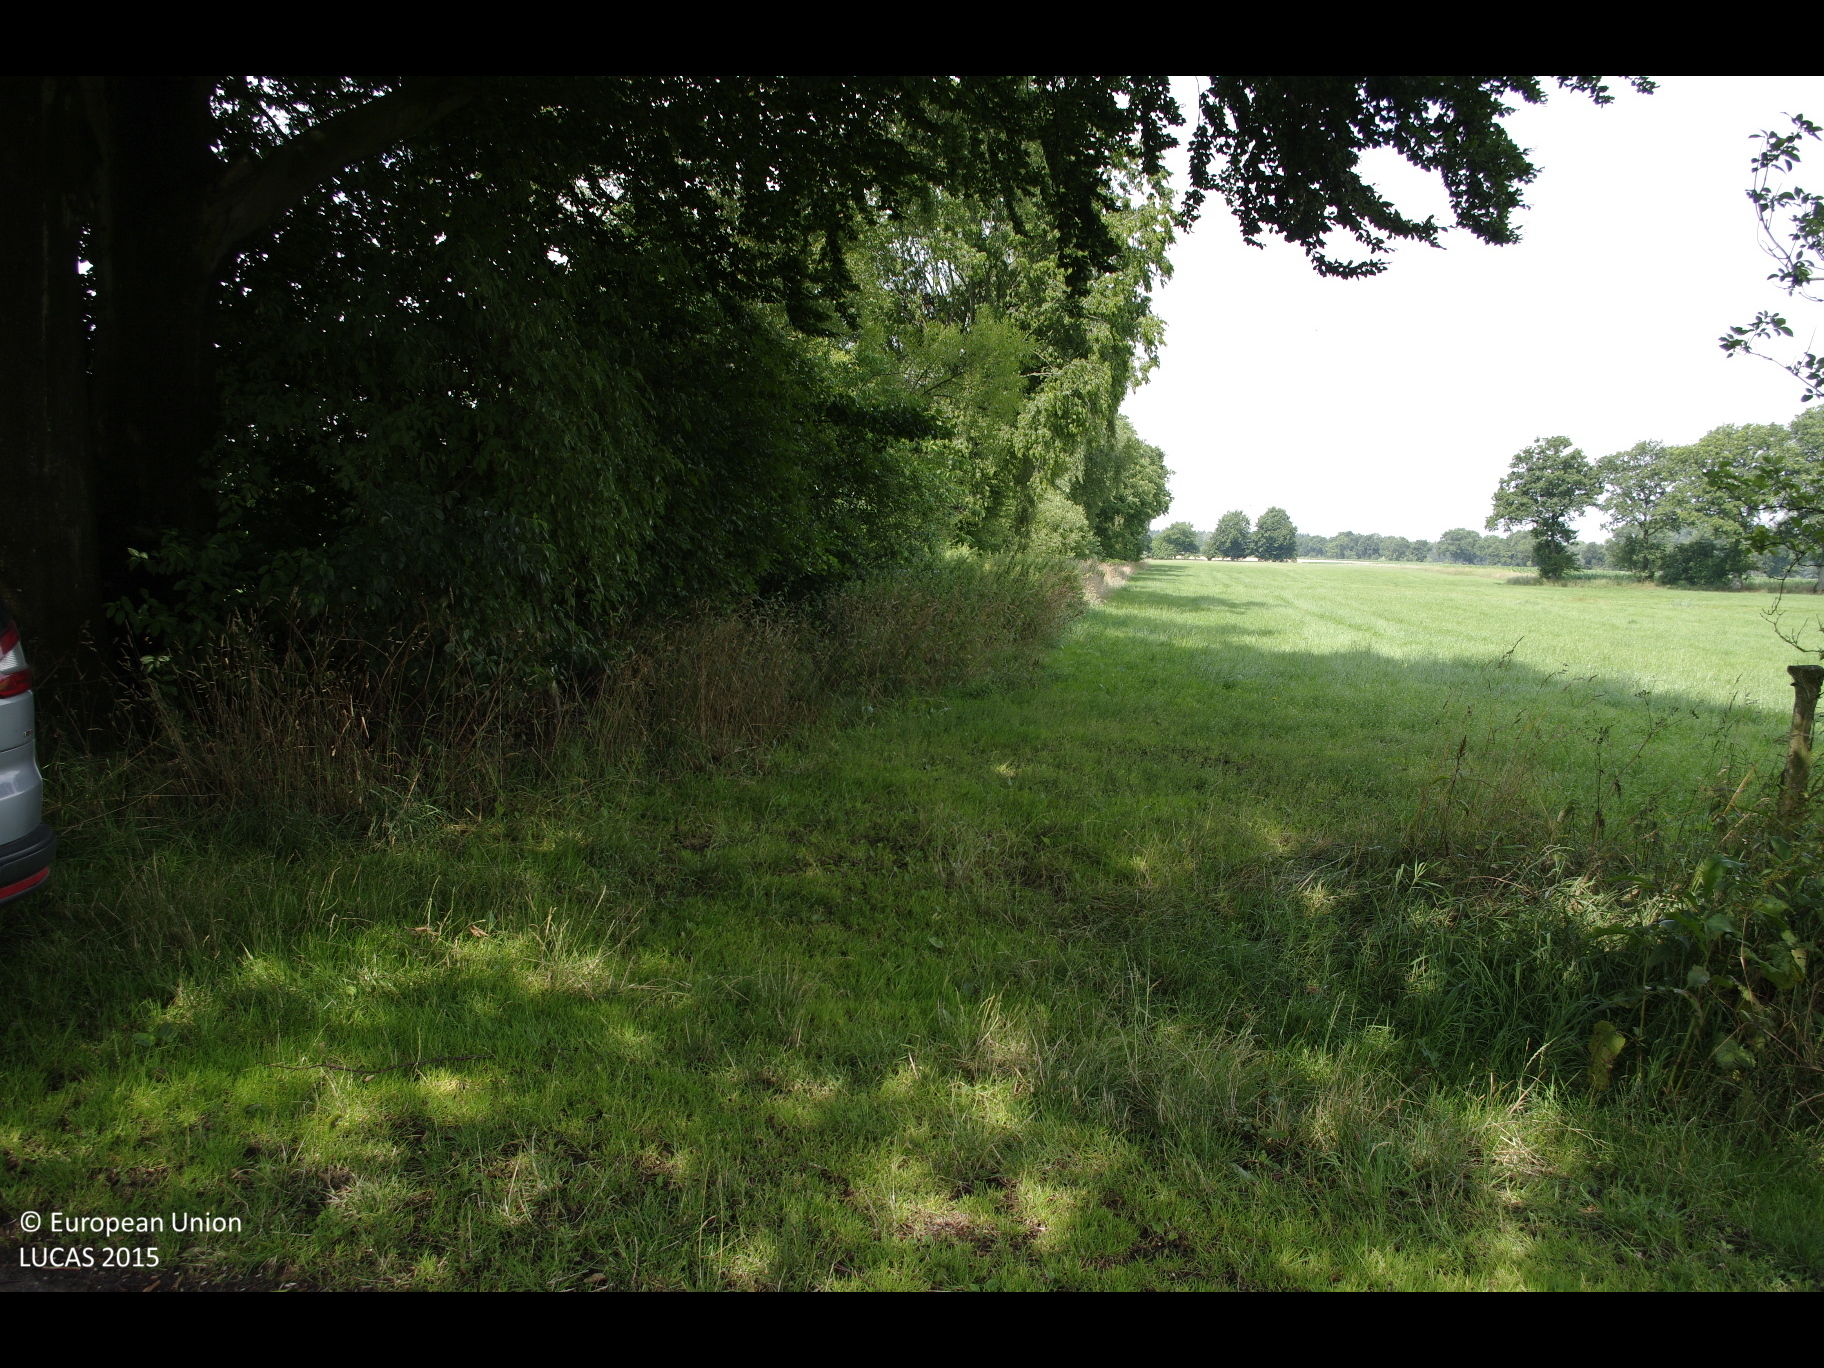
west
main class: Cropland
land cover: Maize
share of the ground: > 75 %
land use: Agriculture (excluding fallow land and kitchen gardens)
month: July
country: DE
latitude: 53.8871
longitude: 9.9544
